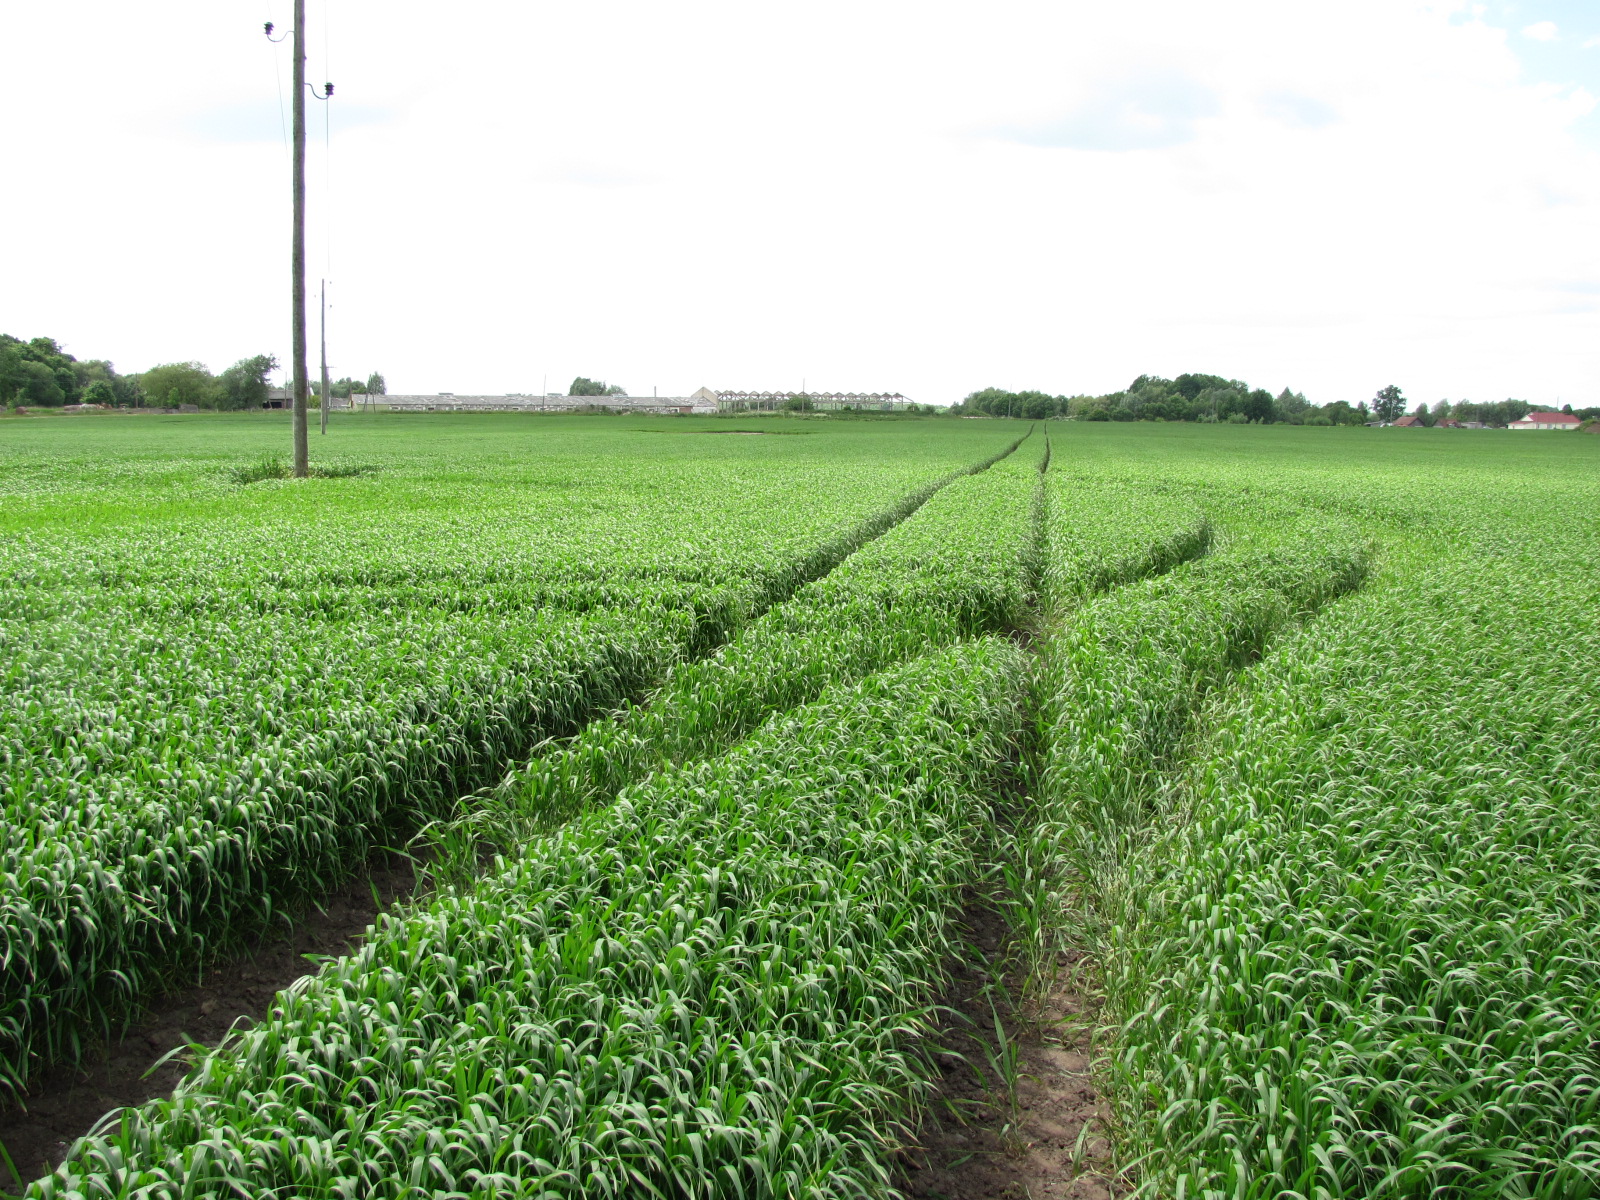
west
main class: Cropland
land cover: Common wheat
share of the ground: > 75 %
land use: Agriculture (excluding fallow land and kitchen gardens)
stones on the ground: < 10 %
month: June
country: LV
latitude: 56.2894
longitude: 24.1942
